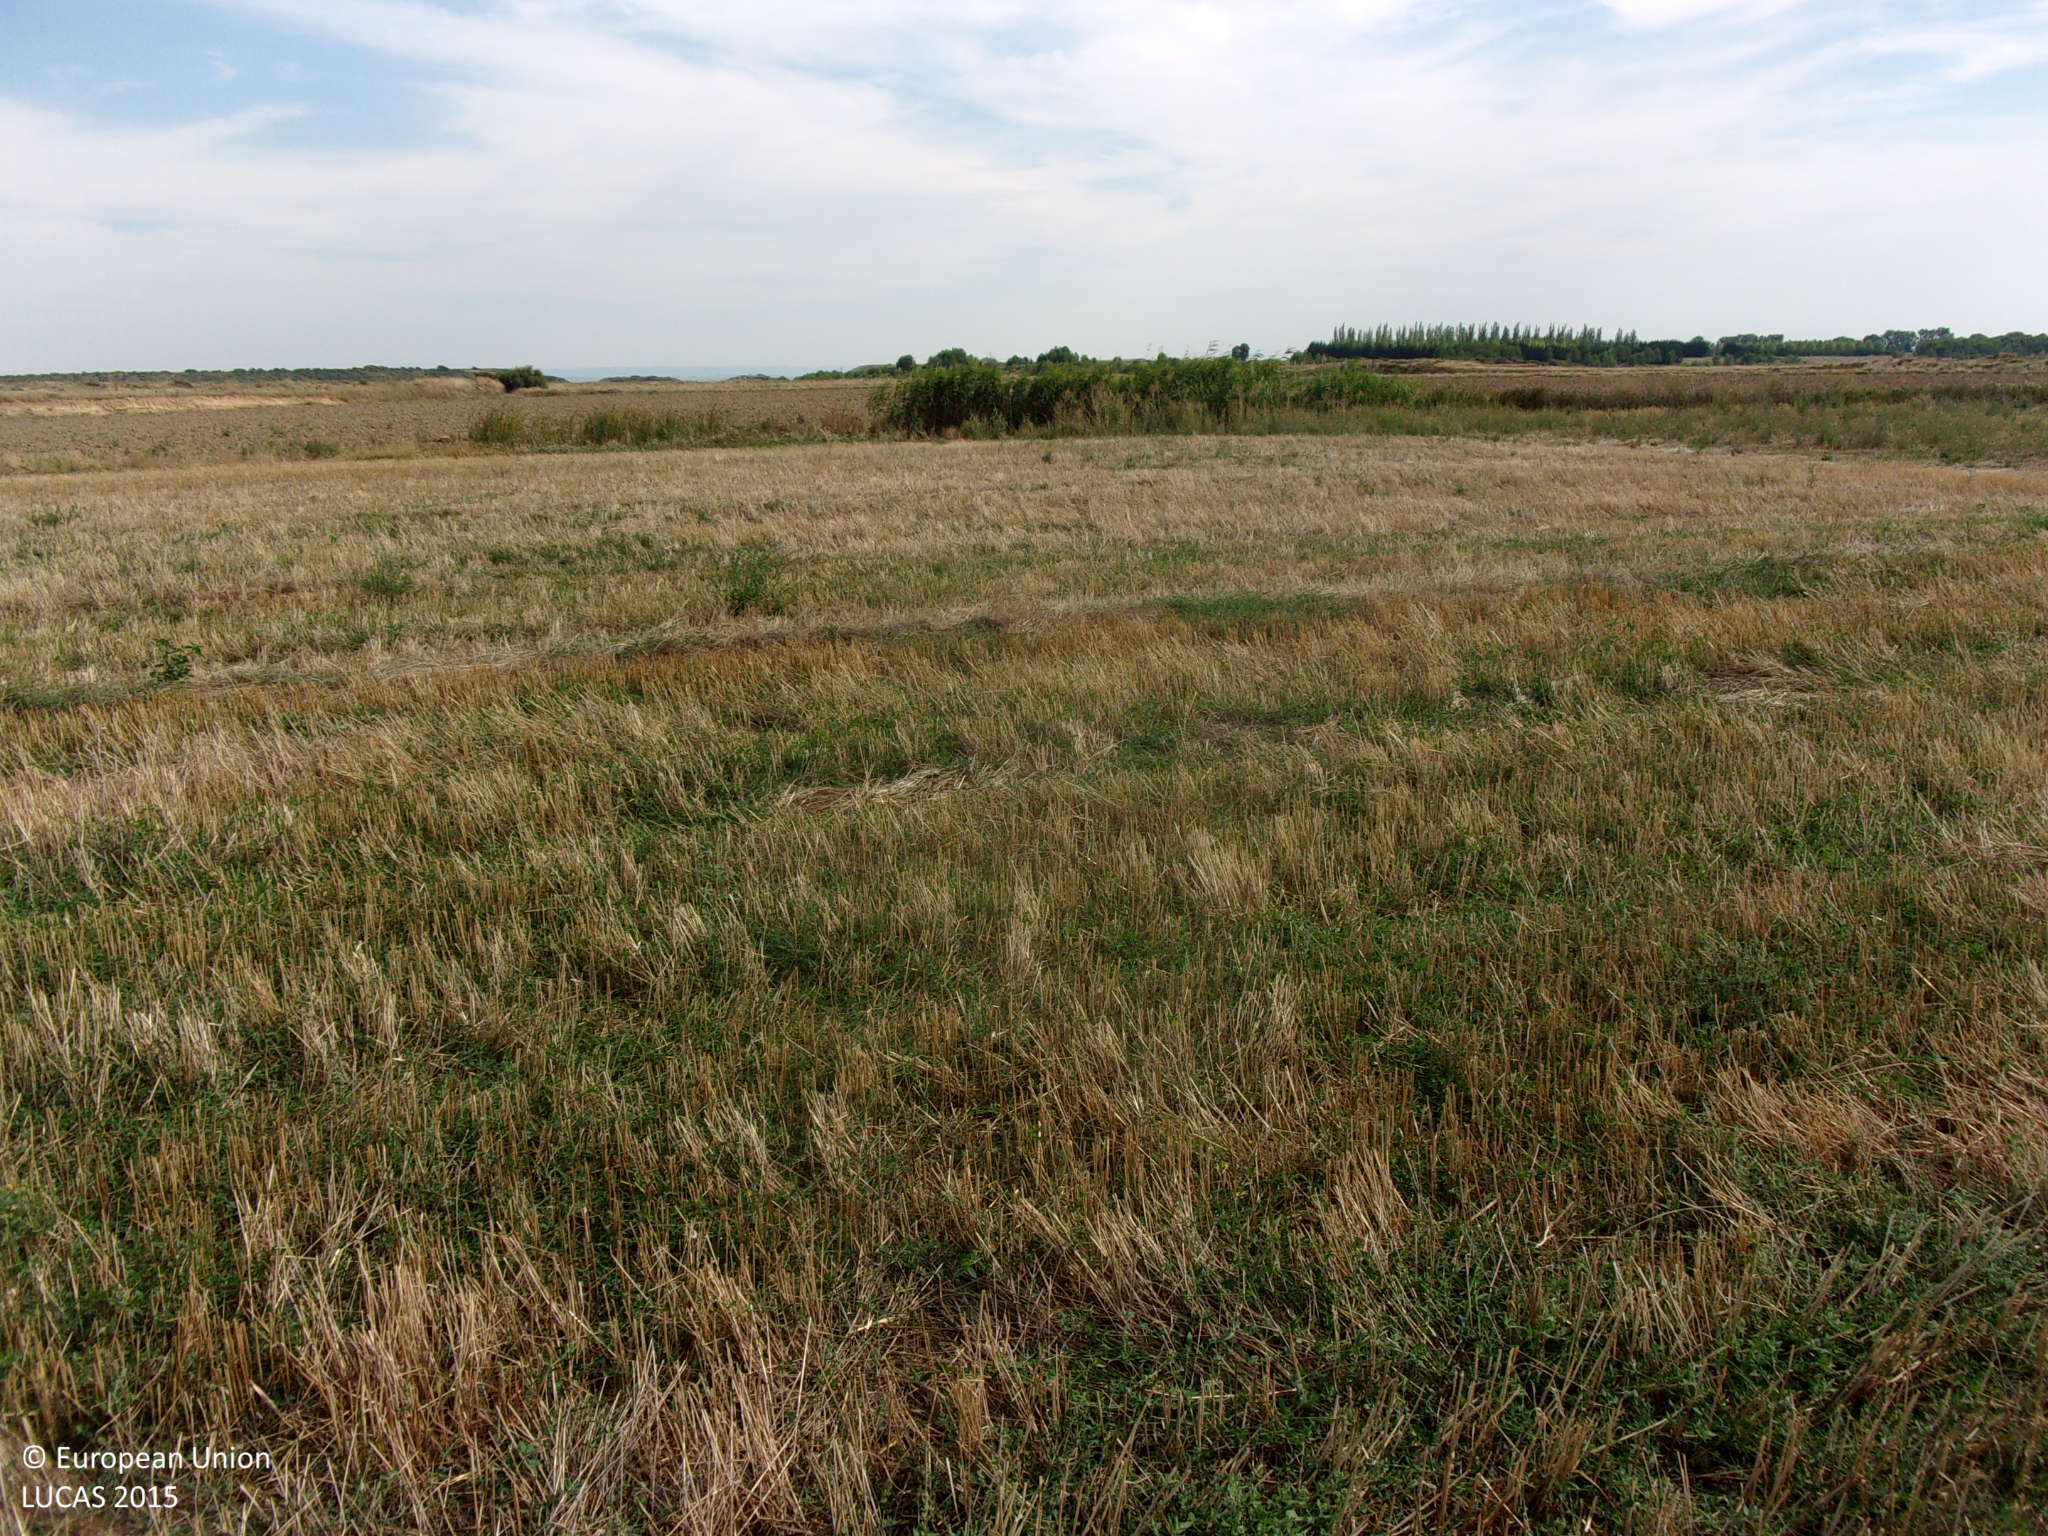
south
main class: Cropland
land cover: Durum wheat
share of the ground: < 10 %
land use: Agriculture (excluding fallow land and kitchen gardens)
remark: Harvested field
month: August
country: ES
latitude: 42.2199
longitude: -1.1381
